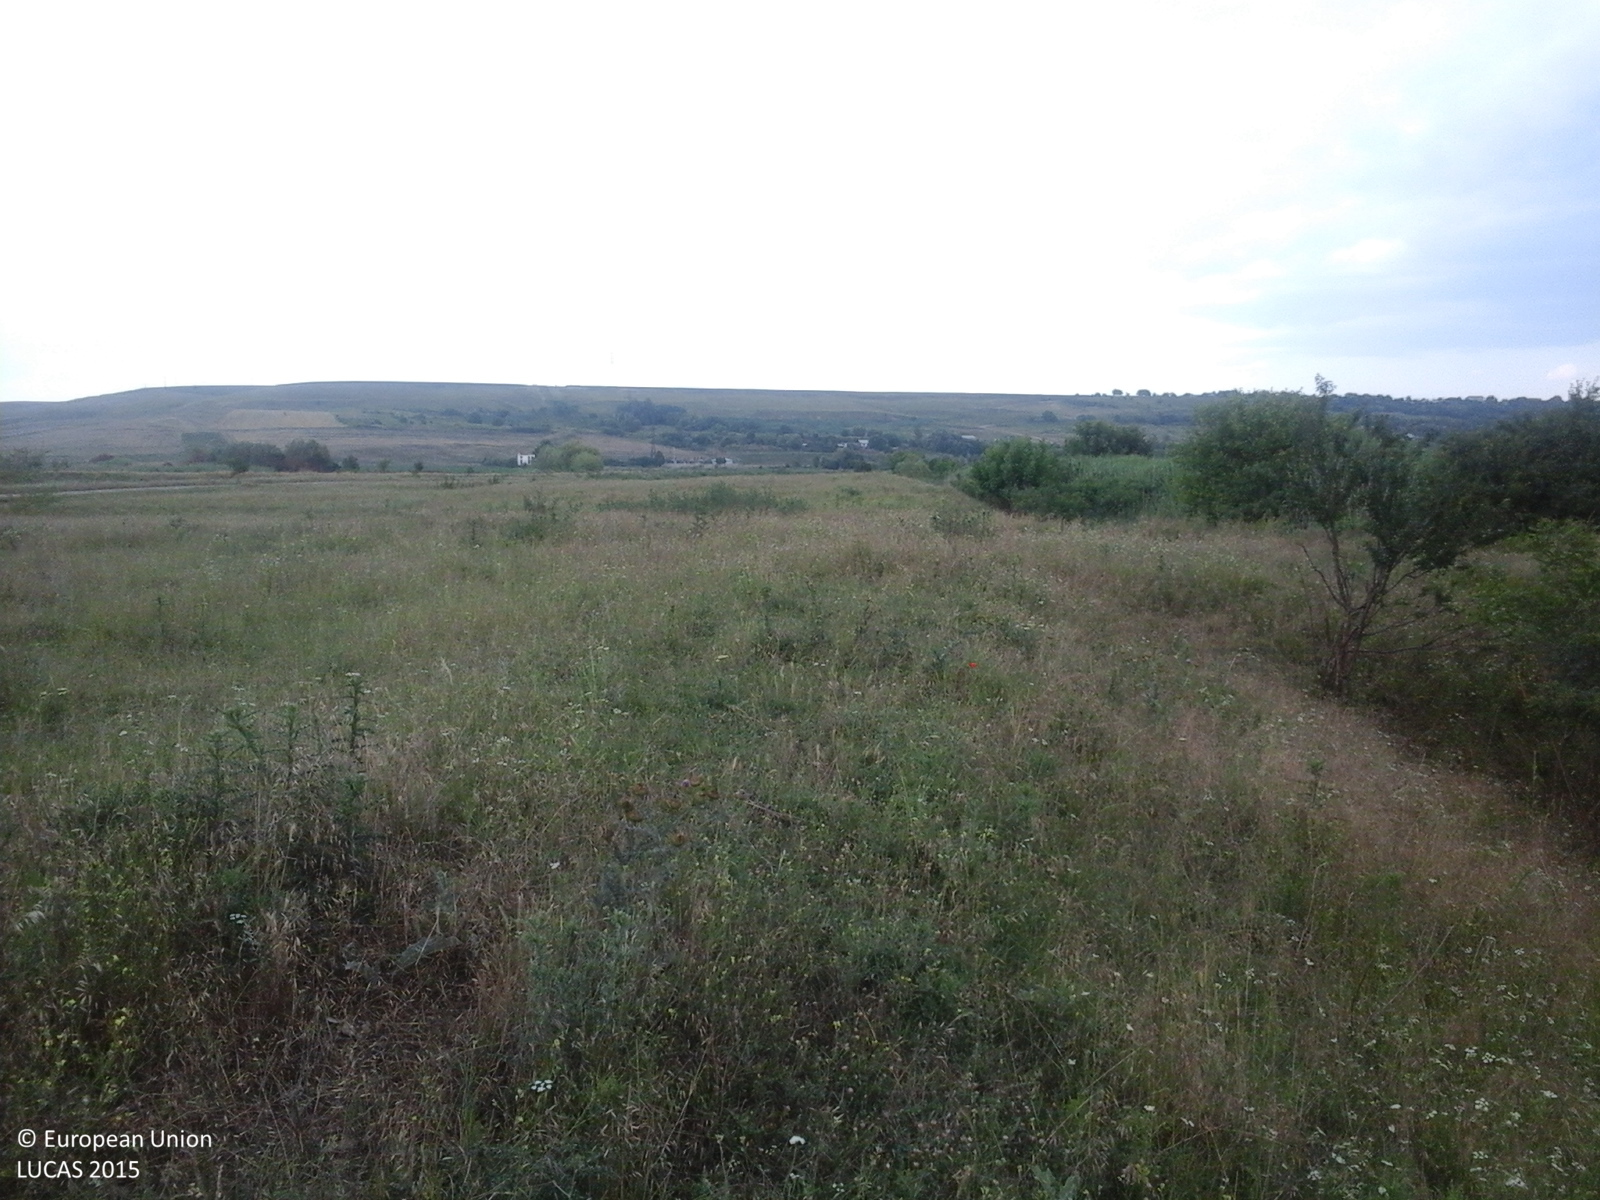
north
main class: Grassland
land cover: Grassland without tree/shrub cover
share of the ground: > 75 %
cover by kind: herbaceous plants 100 %
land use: Agriculture (excluding fallow land and kitchen gardens)
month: June
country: RO
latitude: 44.0639
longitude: 26.1702
